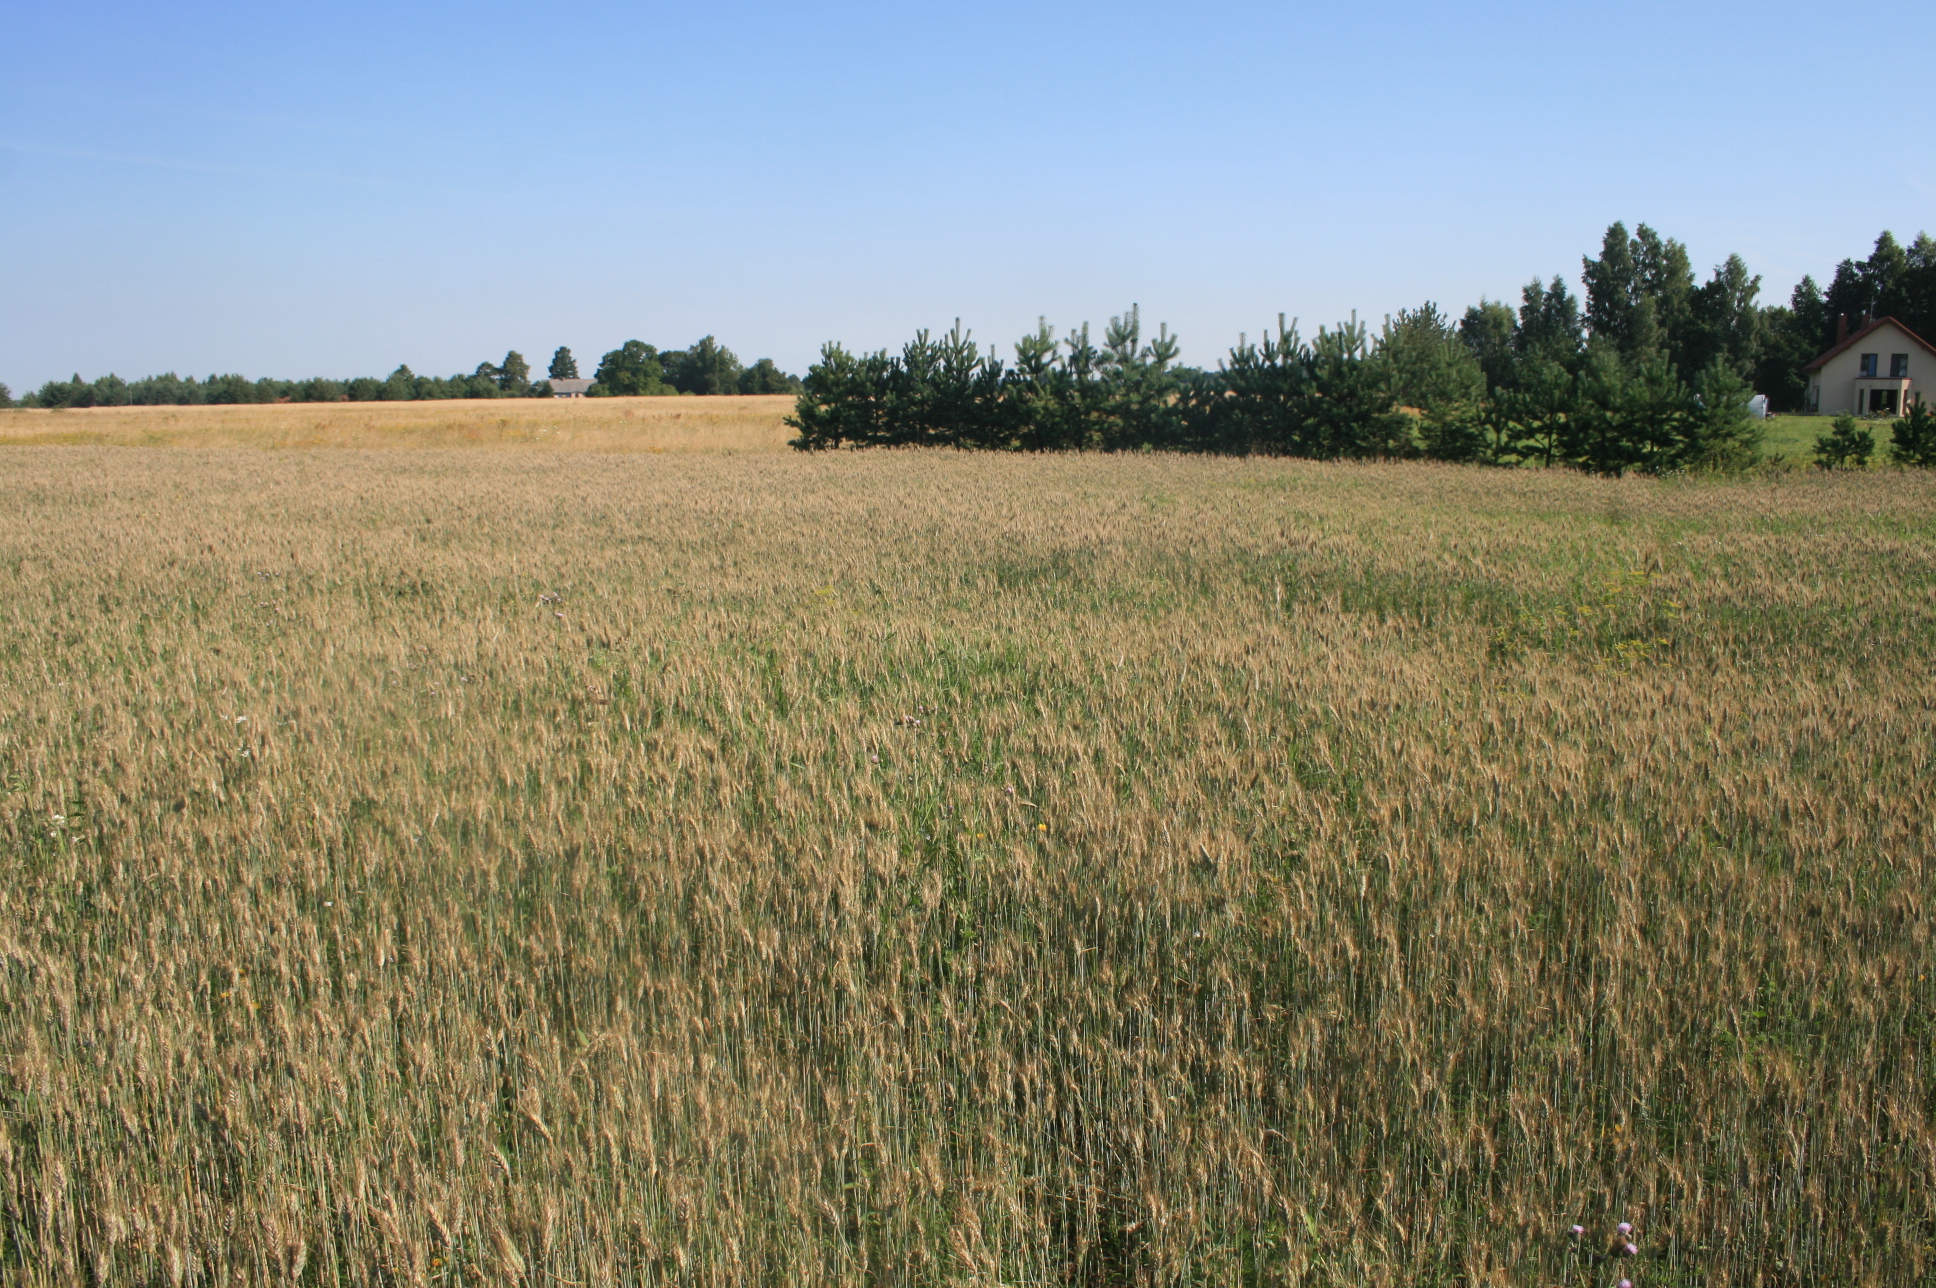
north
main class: Cropland
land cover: Common wheat
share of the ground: > 75 %
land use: Agriculture (excluding fallow land and kitchen gardens)
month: August
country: LT
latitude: 55.6263
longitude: 21.3672
